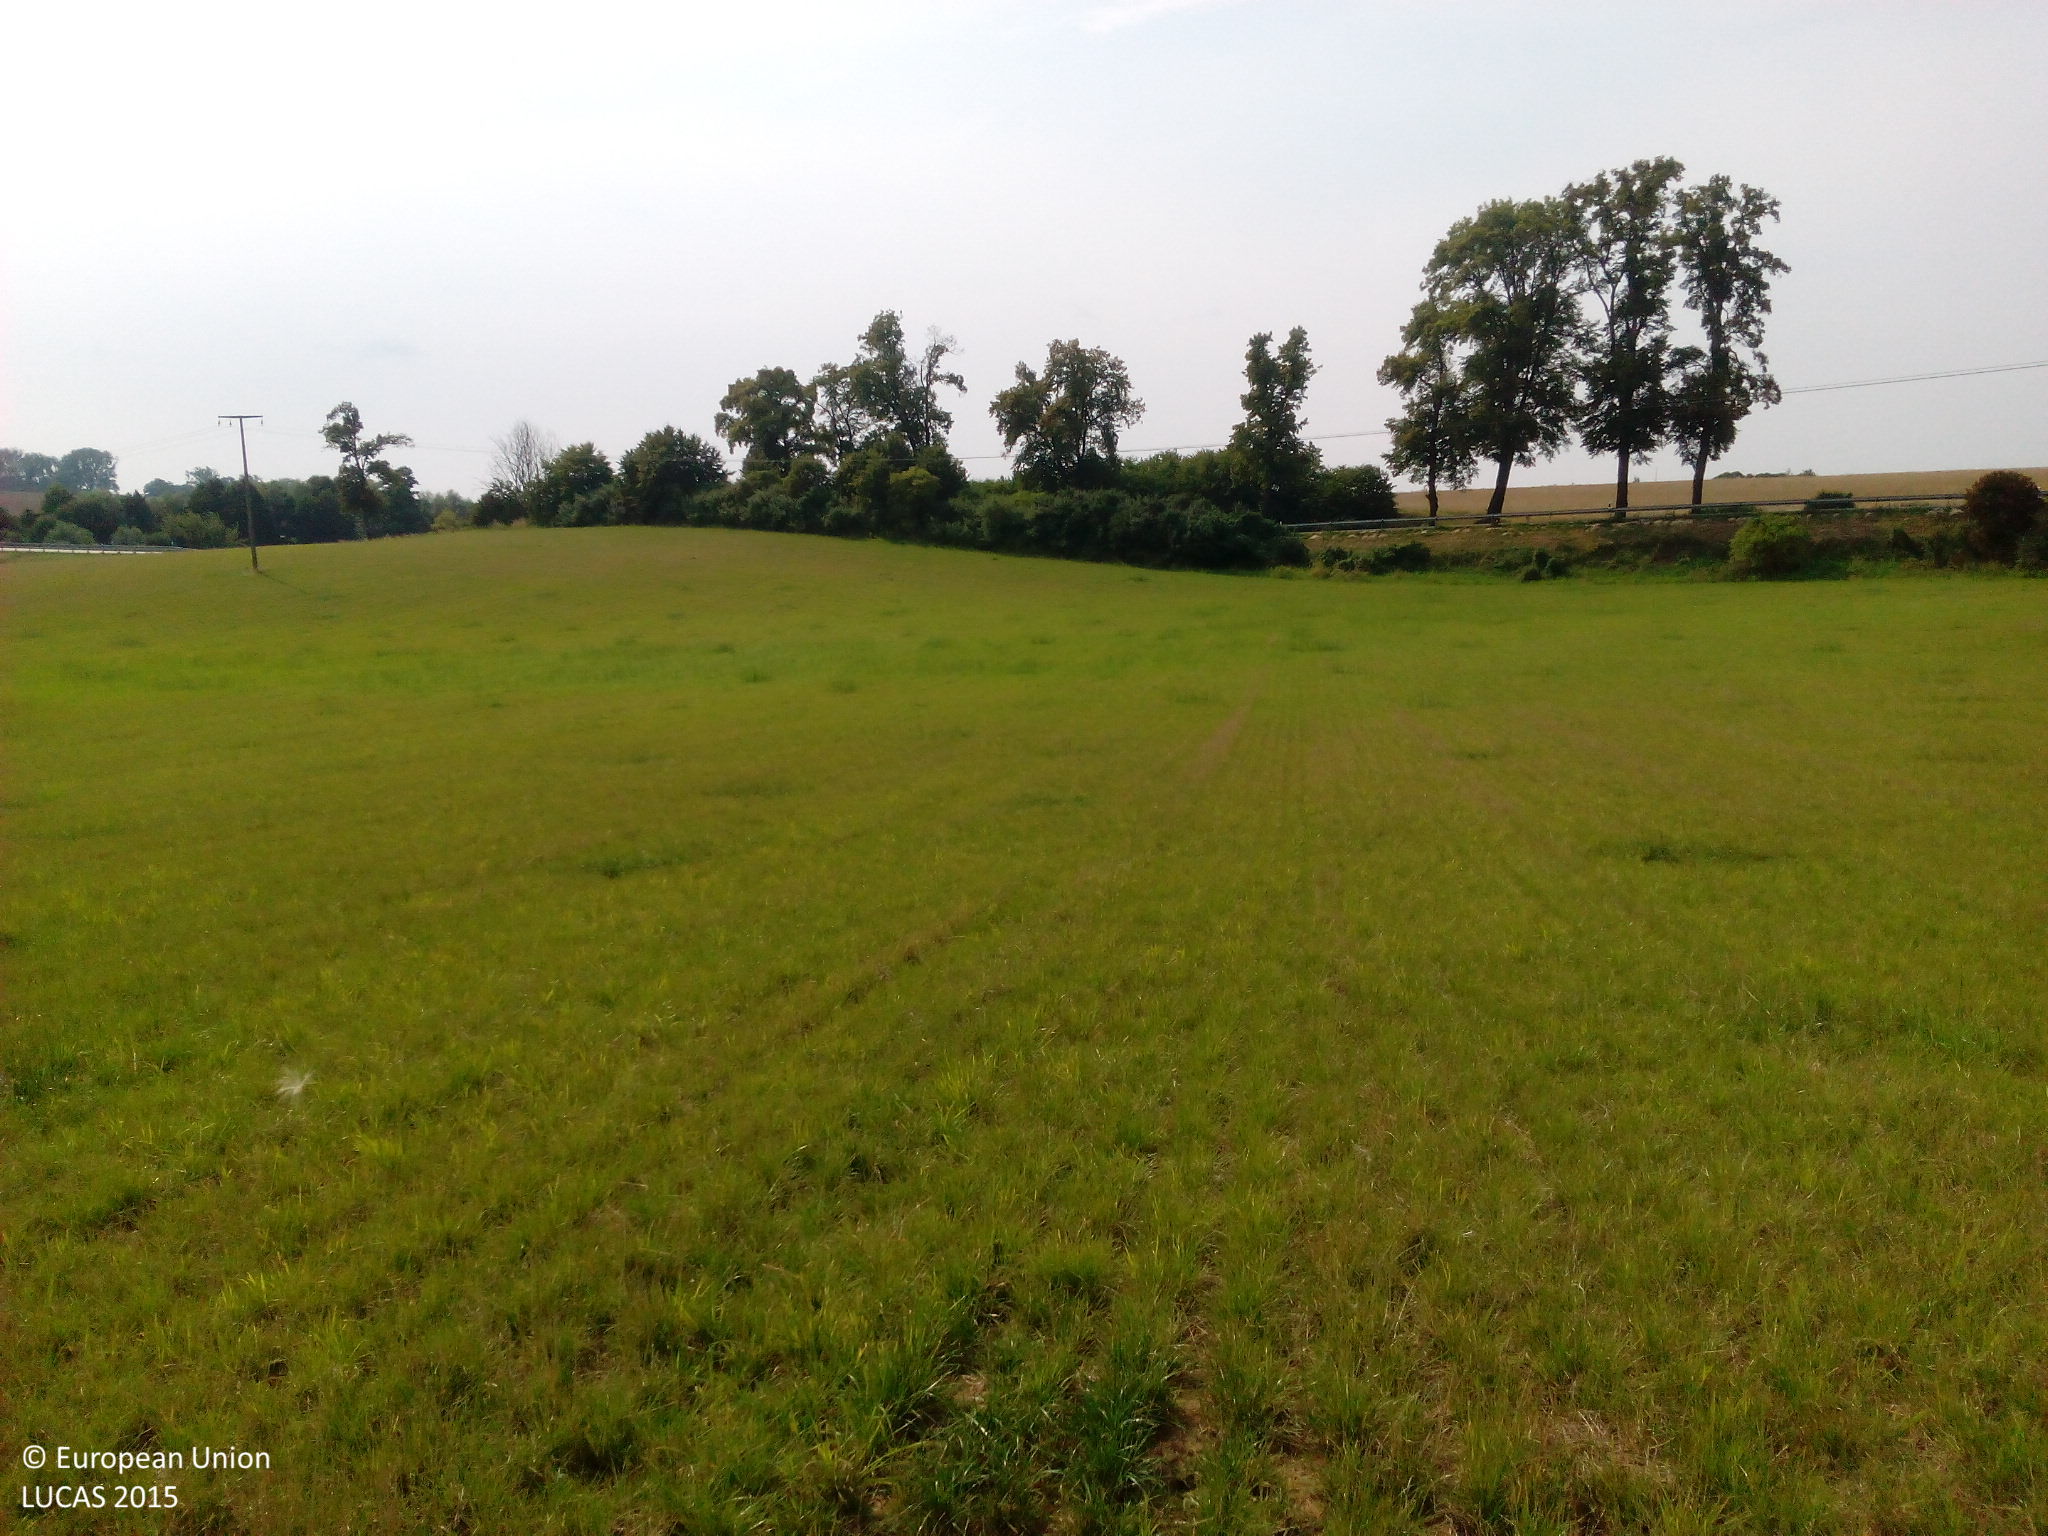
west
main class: Cropland
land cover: Temporary grasslands
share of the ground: > 75 %
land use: Agriculture (excluding fallow land and kitchen gardens)
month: August
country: DE
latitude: 53.4674
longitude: 13.2082
